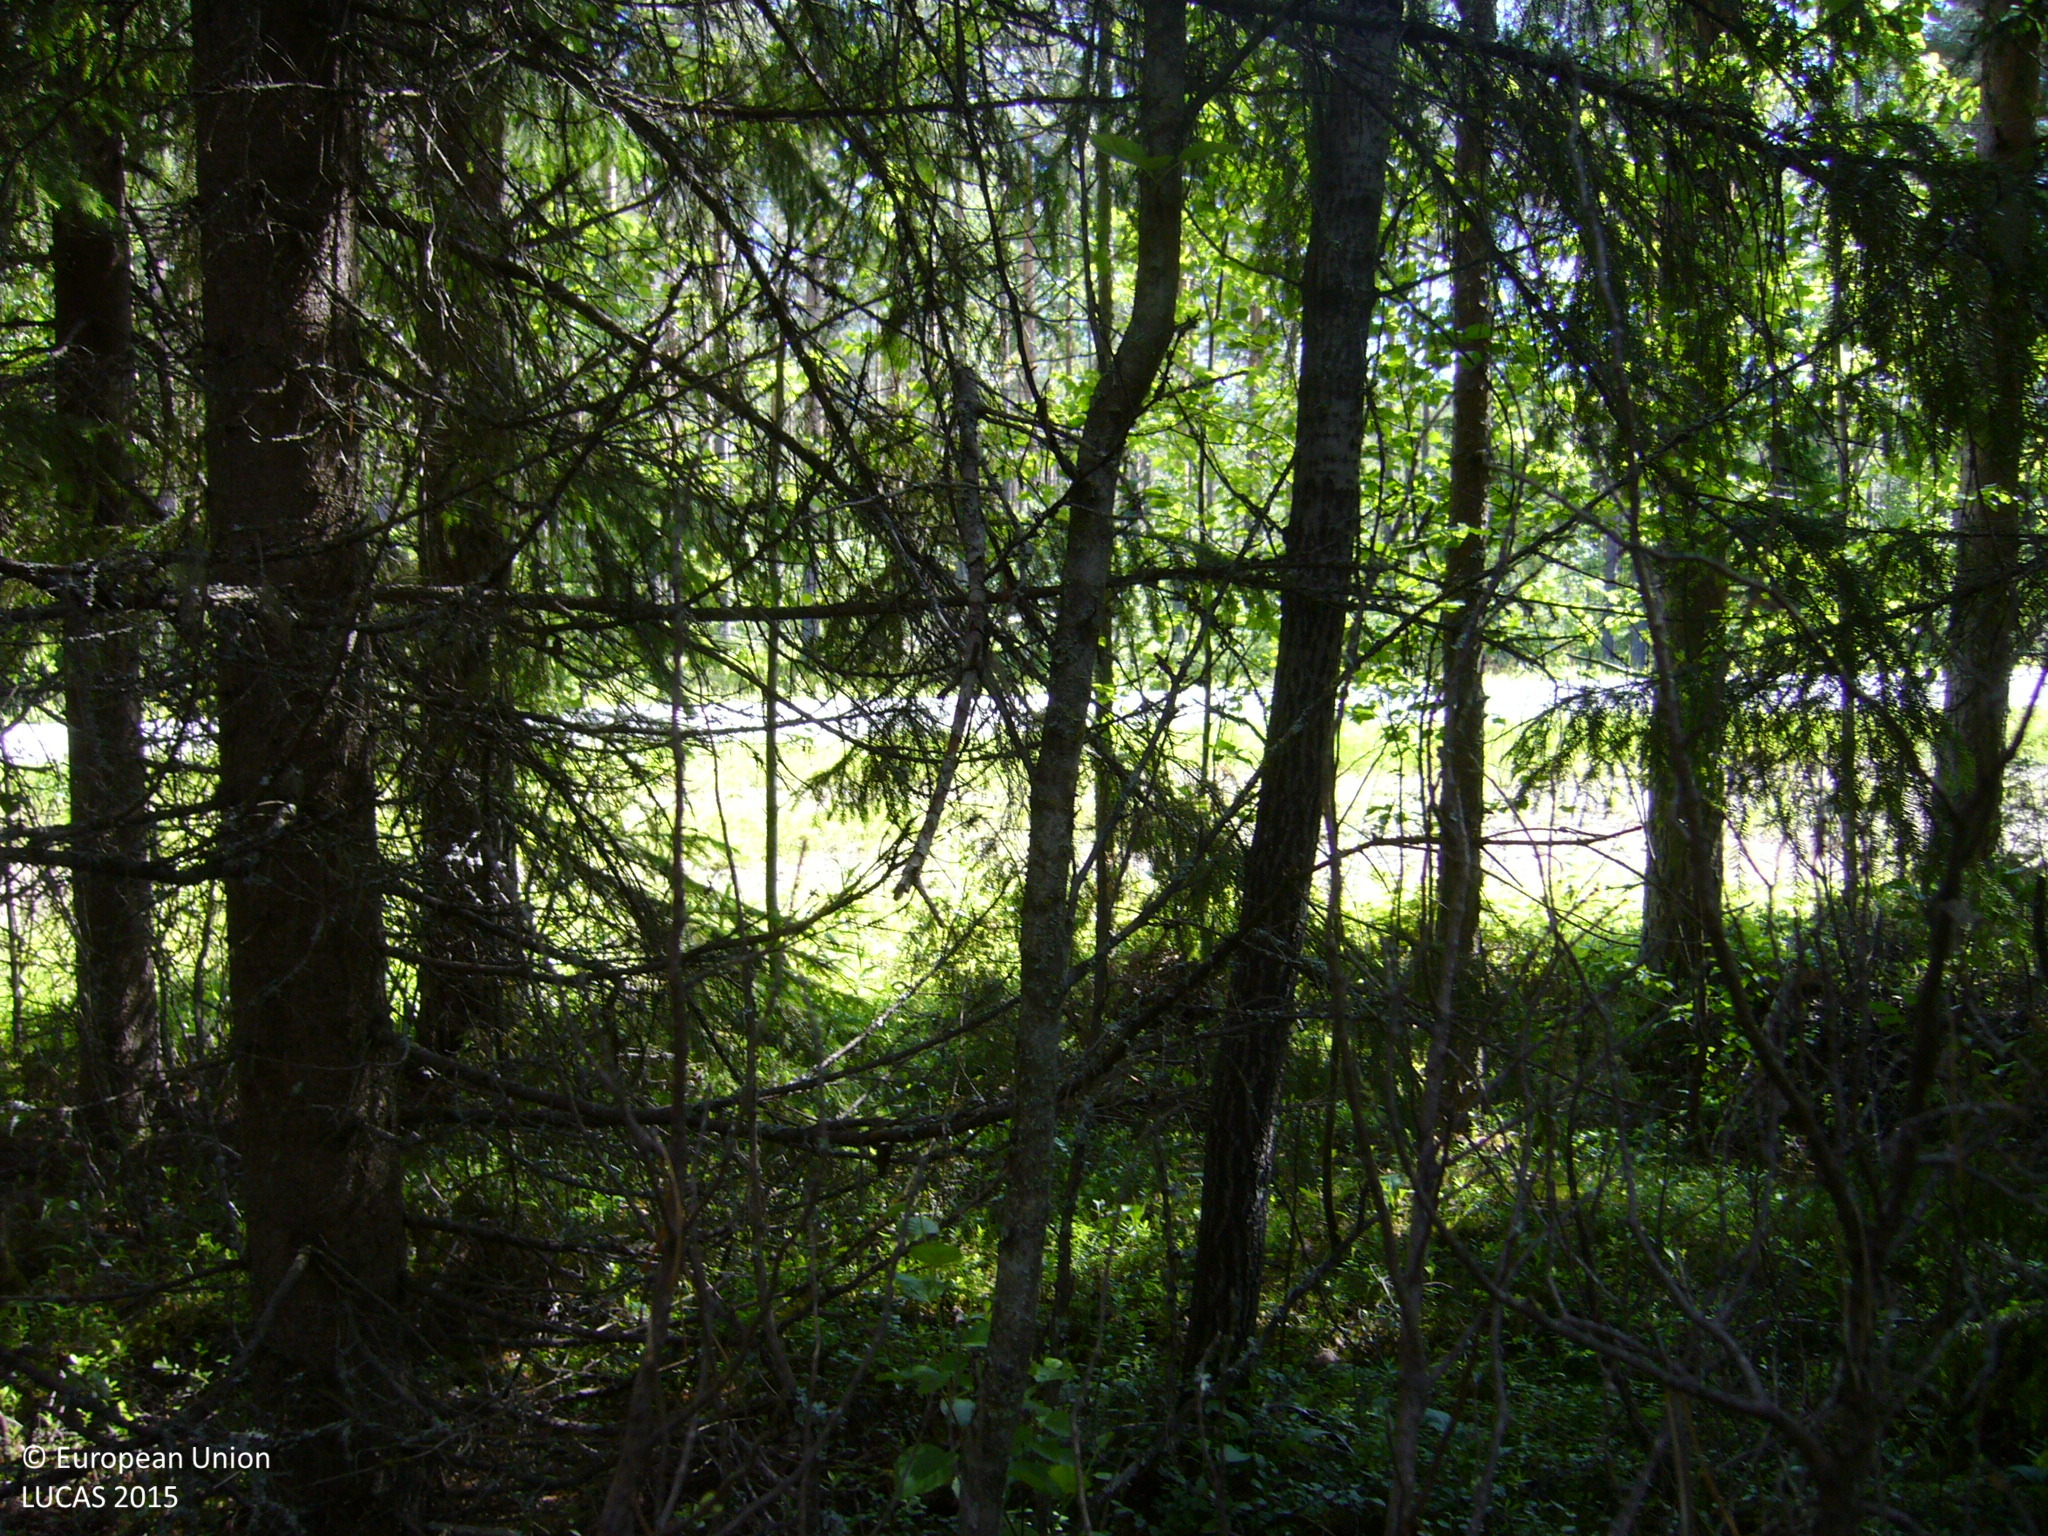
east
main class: Woodland
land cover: Pine dominated mixed woodland
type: boreal forest
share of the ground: > 75 %
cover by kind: coniferous forest trees 50 %, broadleaved forest trees 25 %, shrubs 25 %
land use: Forestry
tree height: > 5 m
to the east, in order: Pine dominated mixed woodland; Shruby margins; Ditches and canals; Spontaneously vegetated surfaces; Paved roads, cycling and walking lanes; Spontaneously vegetated surfaces; Ditches and canals; Shruby margins; Pine dominated coniferous woodland; Tracks; Pine dominated coniferous woodland; Spruce dominated coniferous woodland; Rivers and streams; Spruce dominated coniferous woodland
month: July
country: FI
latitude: 63.5911
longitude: 26.0541
